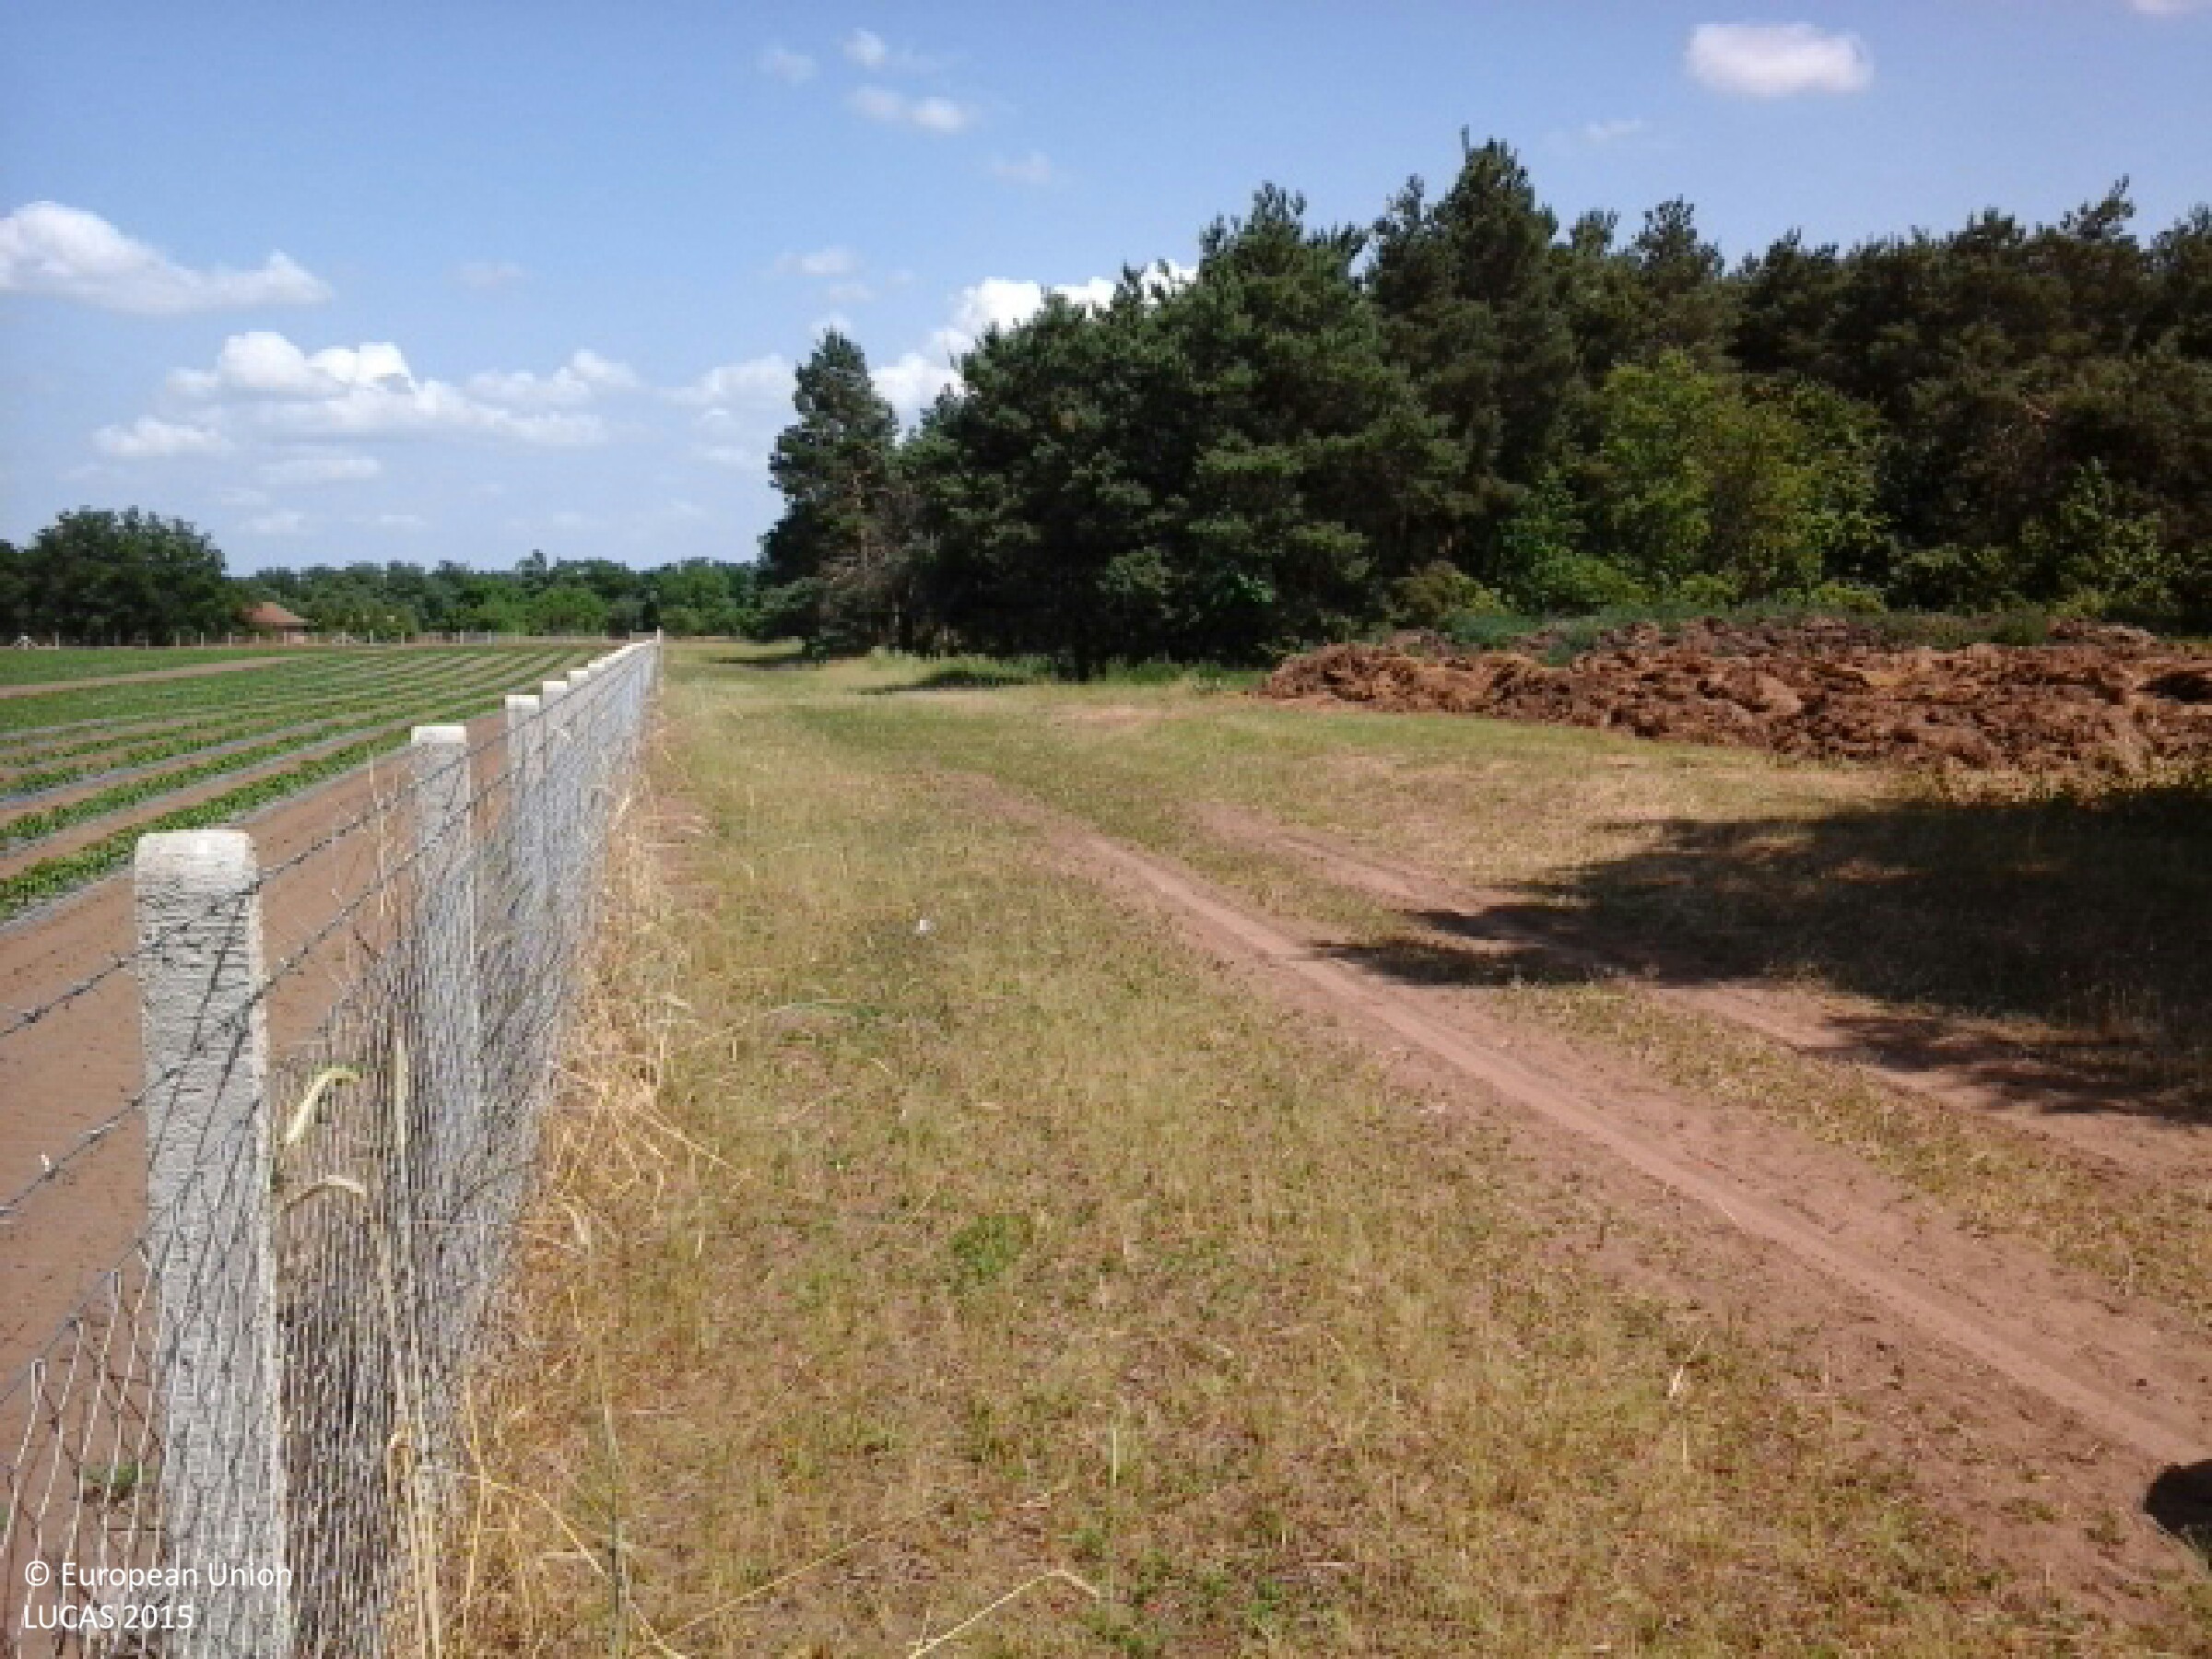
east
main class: Cropland
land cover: Other fresh vegetables
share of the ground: 10 - 25 %
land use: Agriculture (excluding fallow land and kitchen gardens)
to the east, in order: Other fresh vegetables; Fences; Grassland without tree/shrub cover; Tracks; Grass margins; Fences; Nuts trees
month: June
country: HU
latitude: 47.8745
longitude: 21.6656
